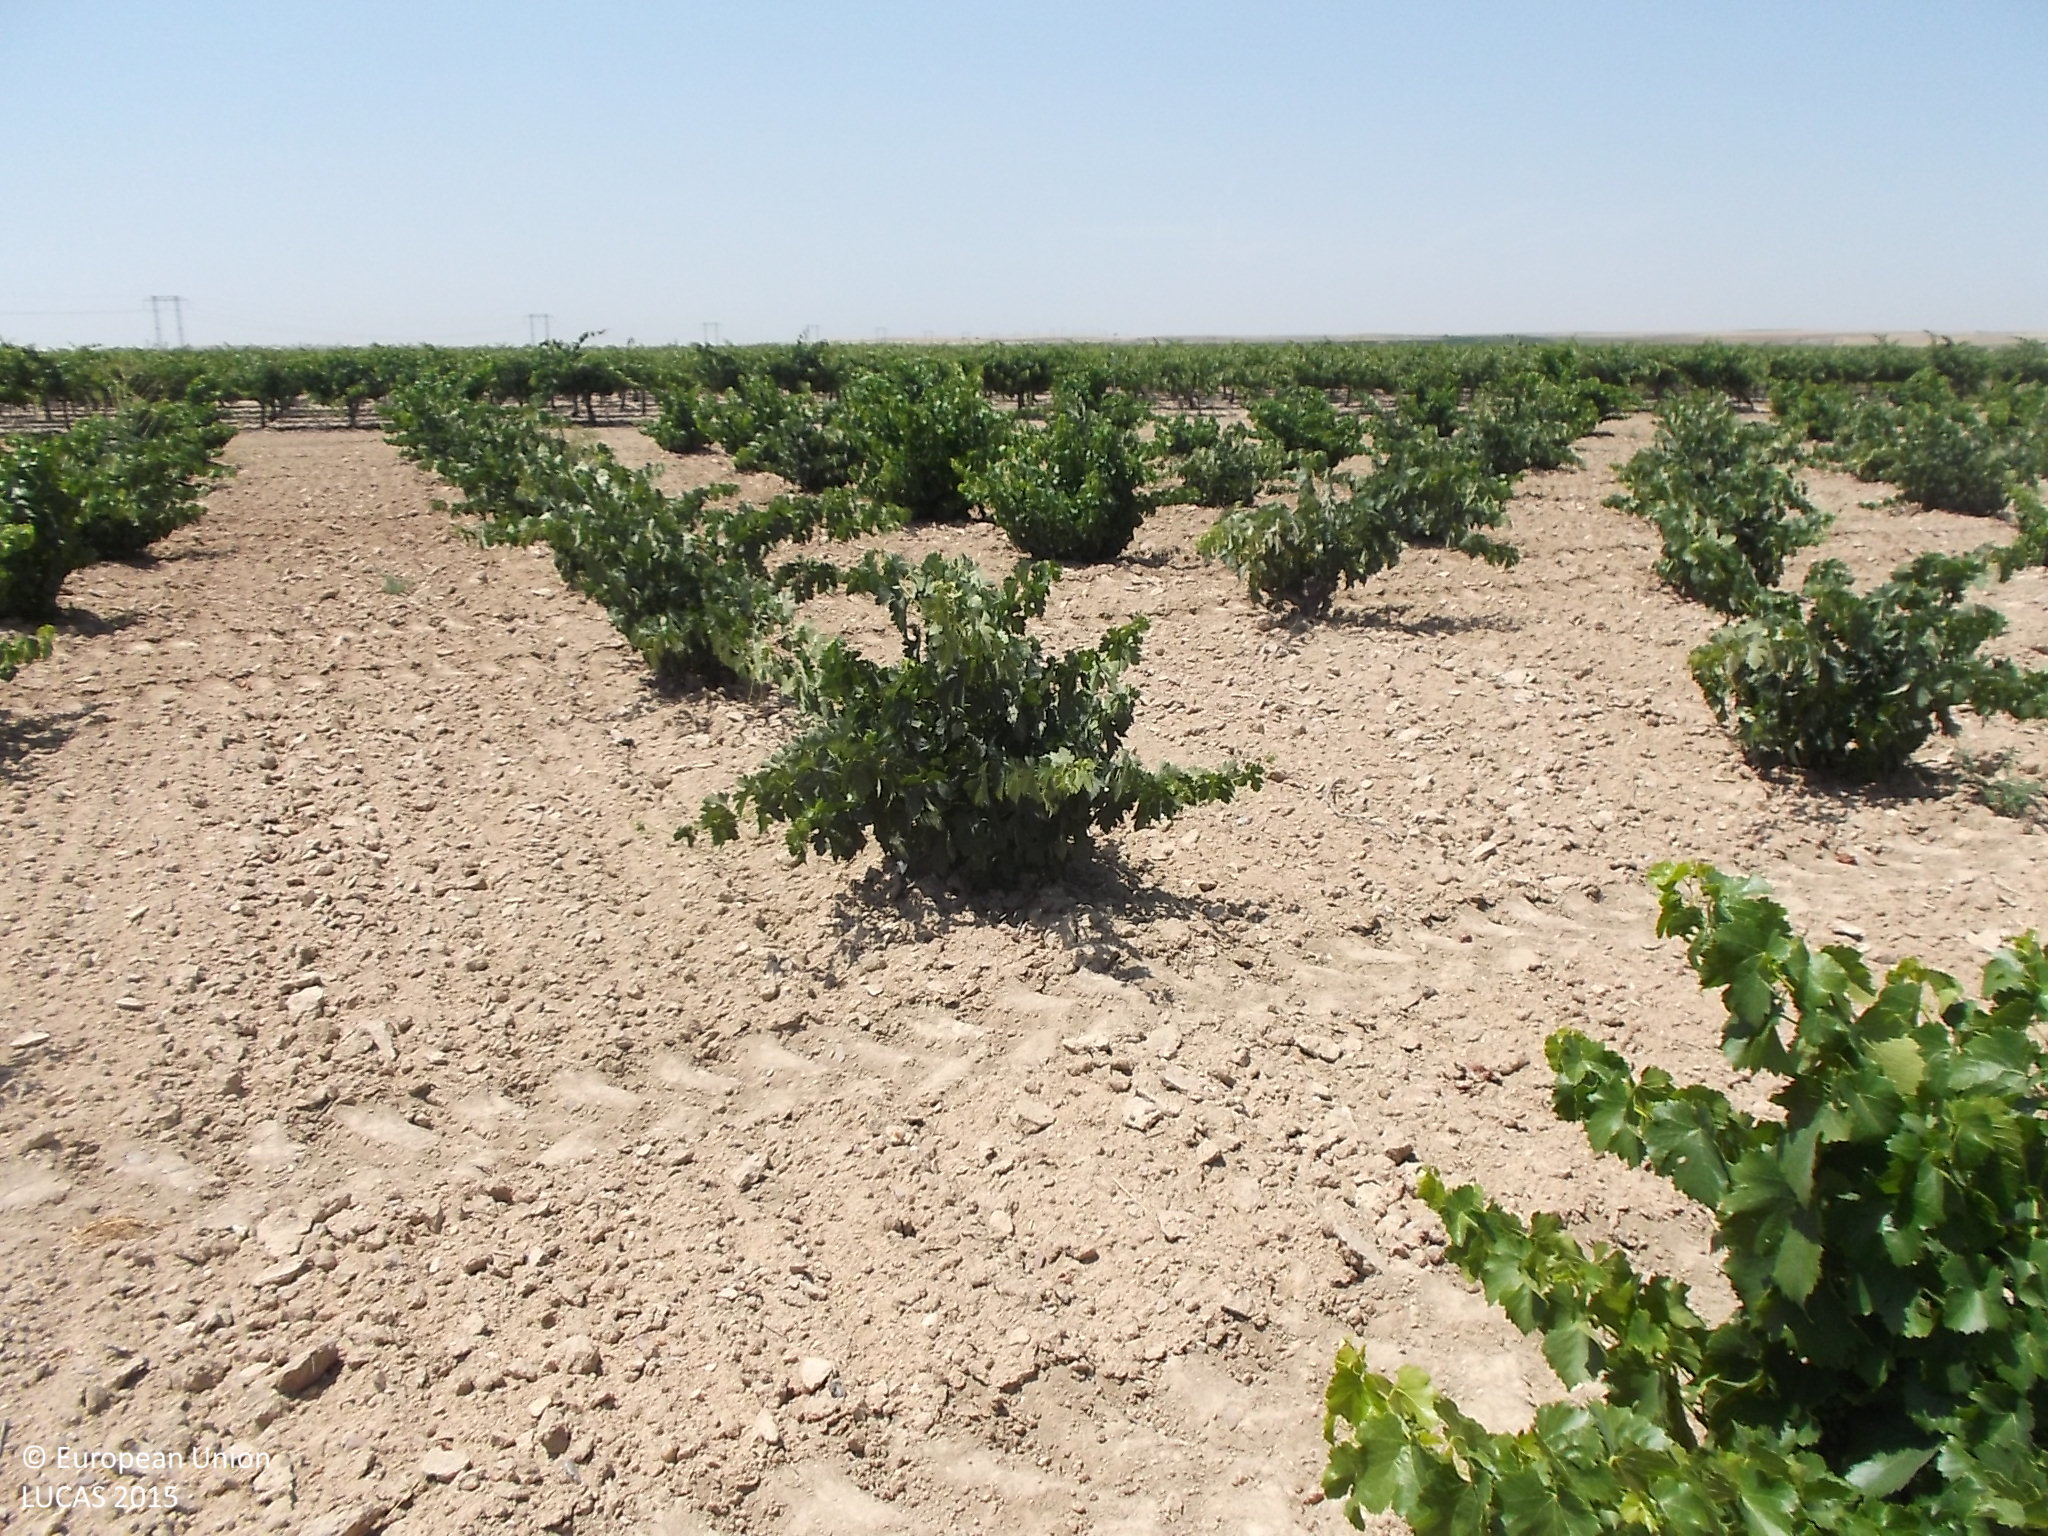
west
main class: Cropland
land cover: Vineyards
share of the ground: 10 - 25 %
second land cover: Other bare soil
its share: > 75 %
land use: Agriculture (excluding fallow land and kitchen gardens)
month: July
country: ES
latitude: 41.5544
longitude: -5.3173
